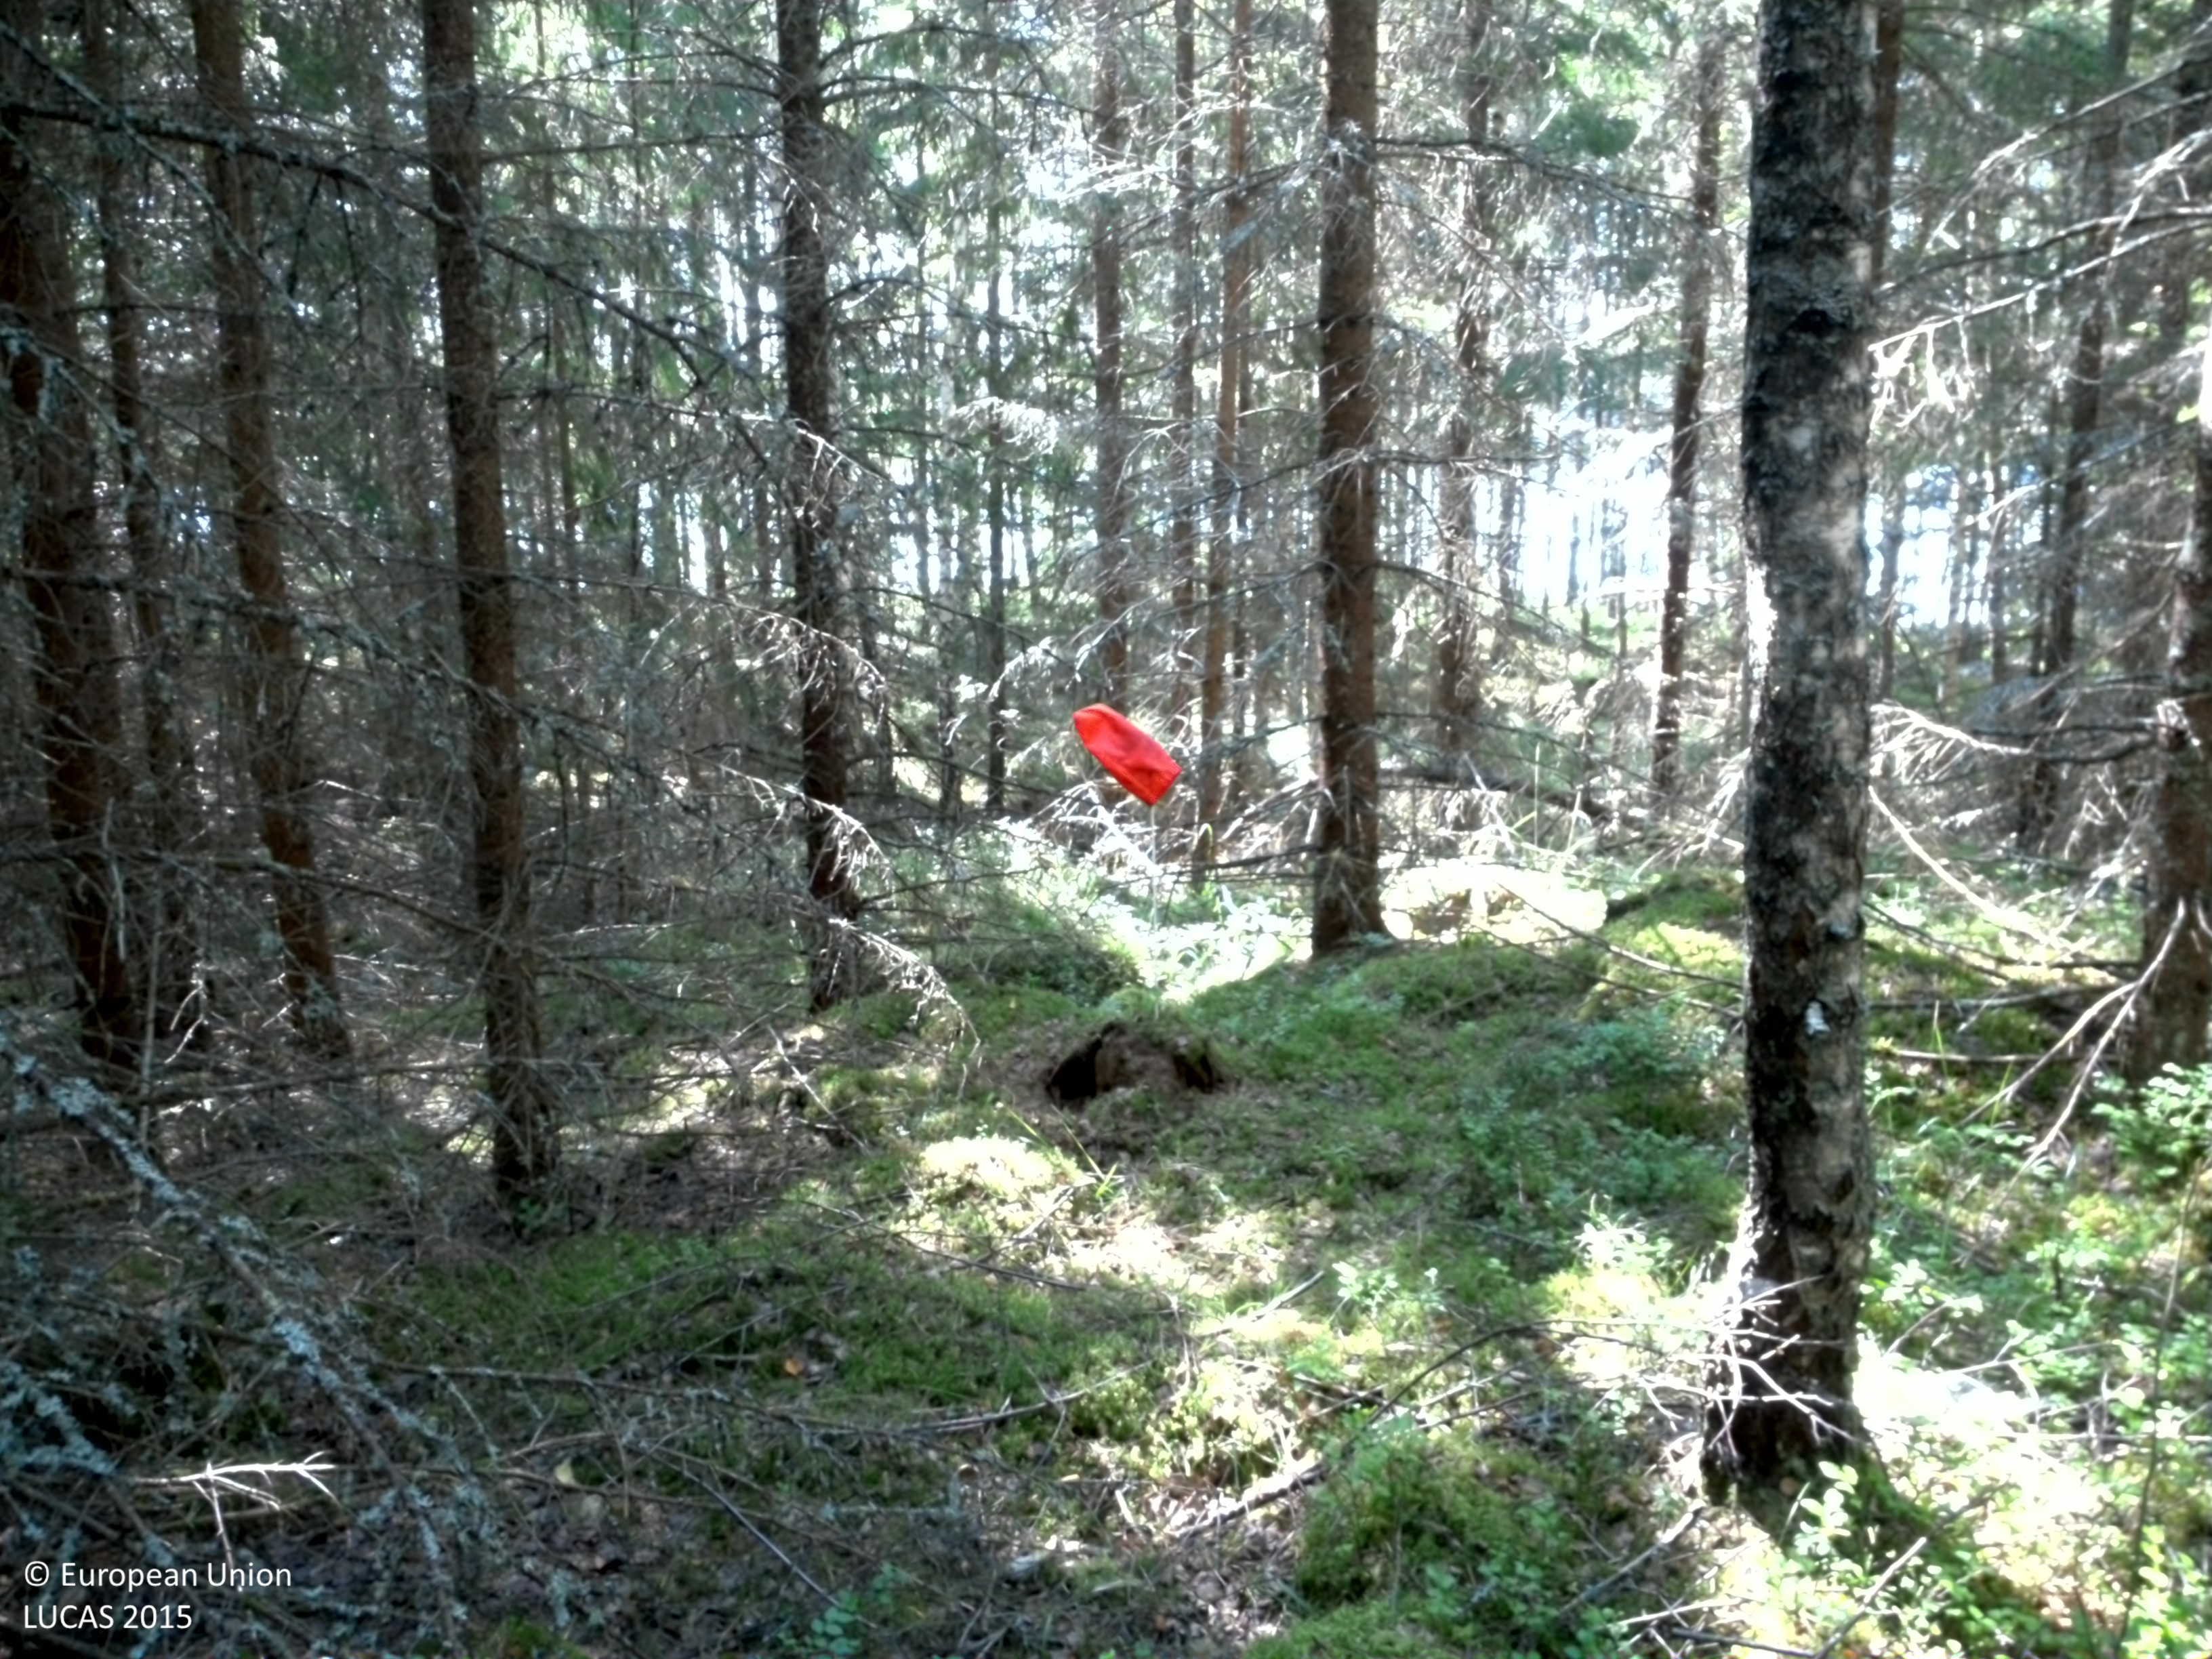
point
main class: Woodland
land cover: Spruce dominated coniferous woodland
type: boreal forest
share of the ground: > 75 %
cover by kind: coniferous forest trees 80 %, lichens and mosses 10 %, broadleaved forest trees 5 %, herbaceous plants 5 %
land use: Forestry
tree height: > 5 m
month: July
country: SE
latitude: 58.7689
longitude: 14.6789
